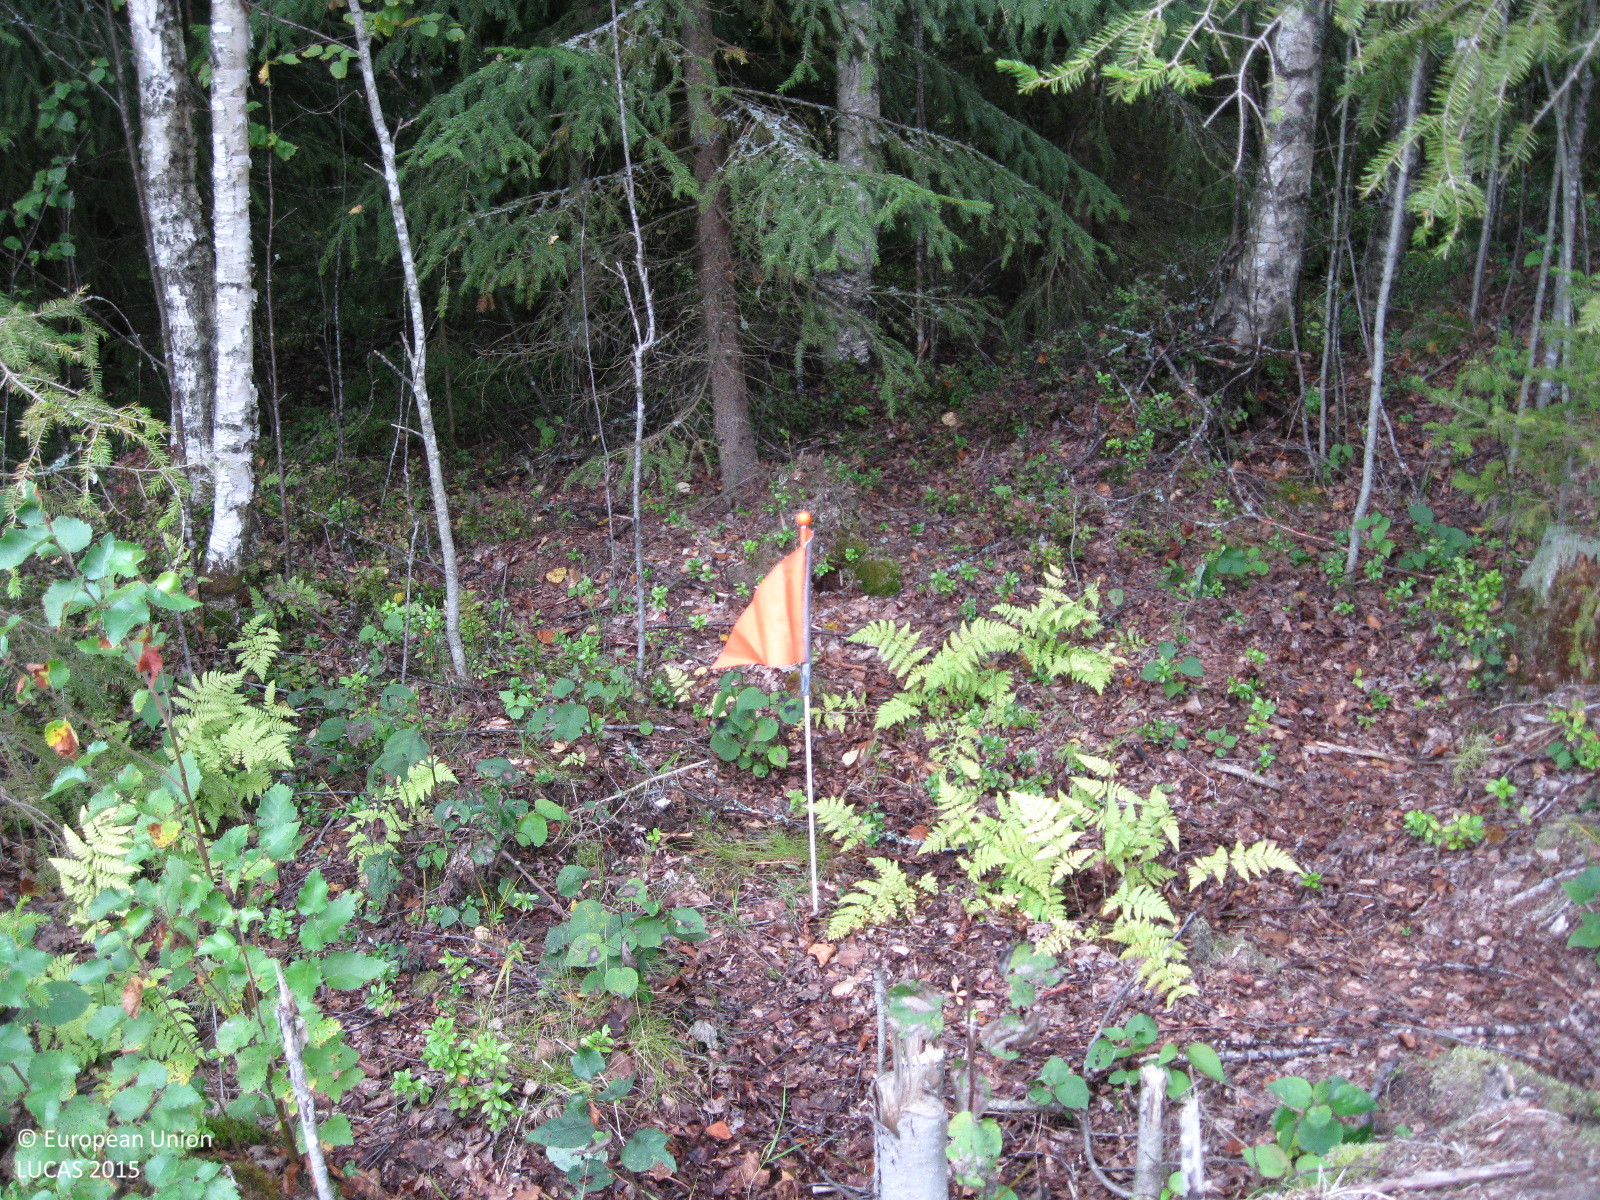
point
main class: Woodland
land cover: Spruce dominated mixed woodland
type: boreal forest
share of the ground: > 75 %
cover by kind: broadleaved forest trees 45 %, coniferous forest trees 40 %, herbaceous plants 10 %, shrubs 5 %
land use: Forestry
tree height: > 5 m
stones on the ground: < 10 %
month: September
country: FI
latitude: 60.8523
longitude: 25.0802
